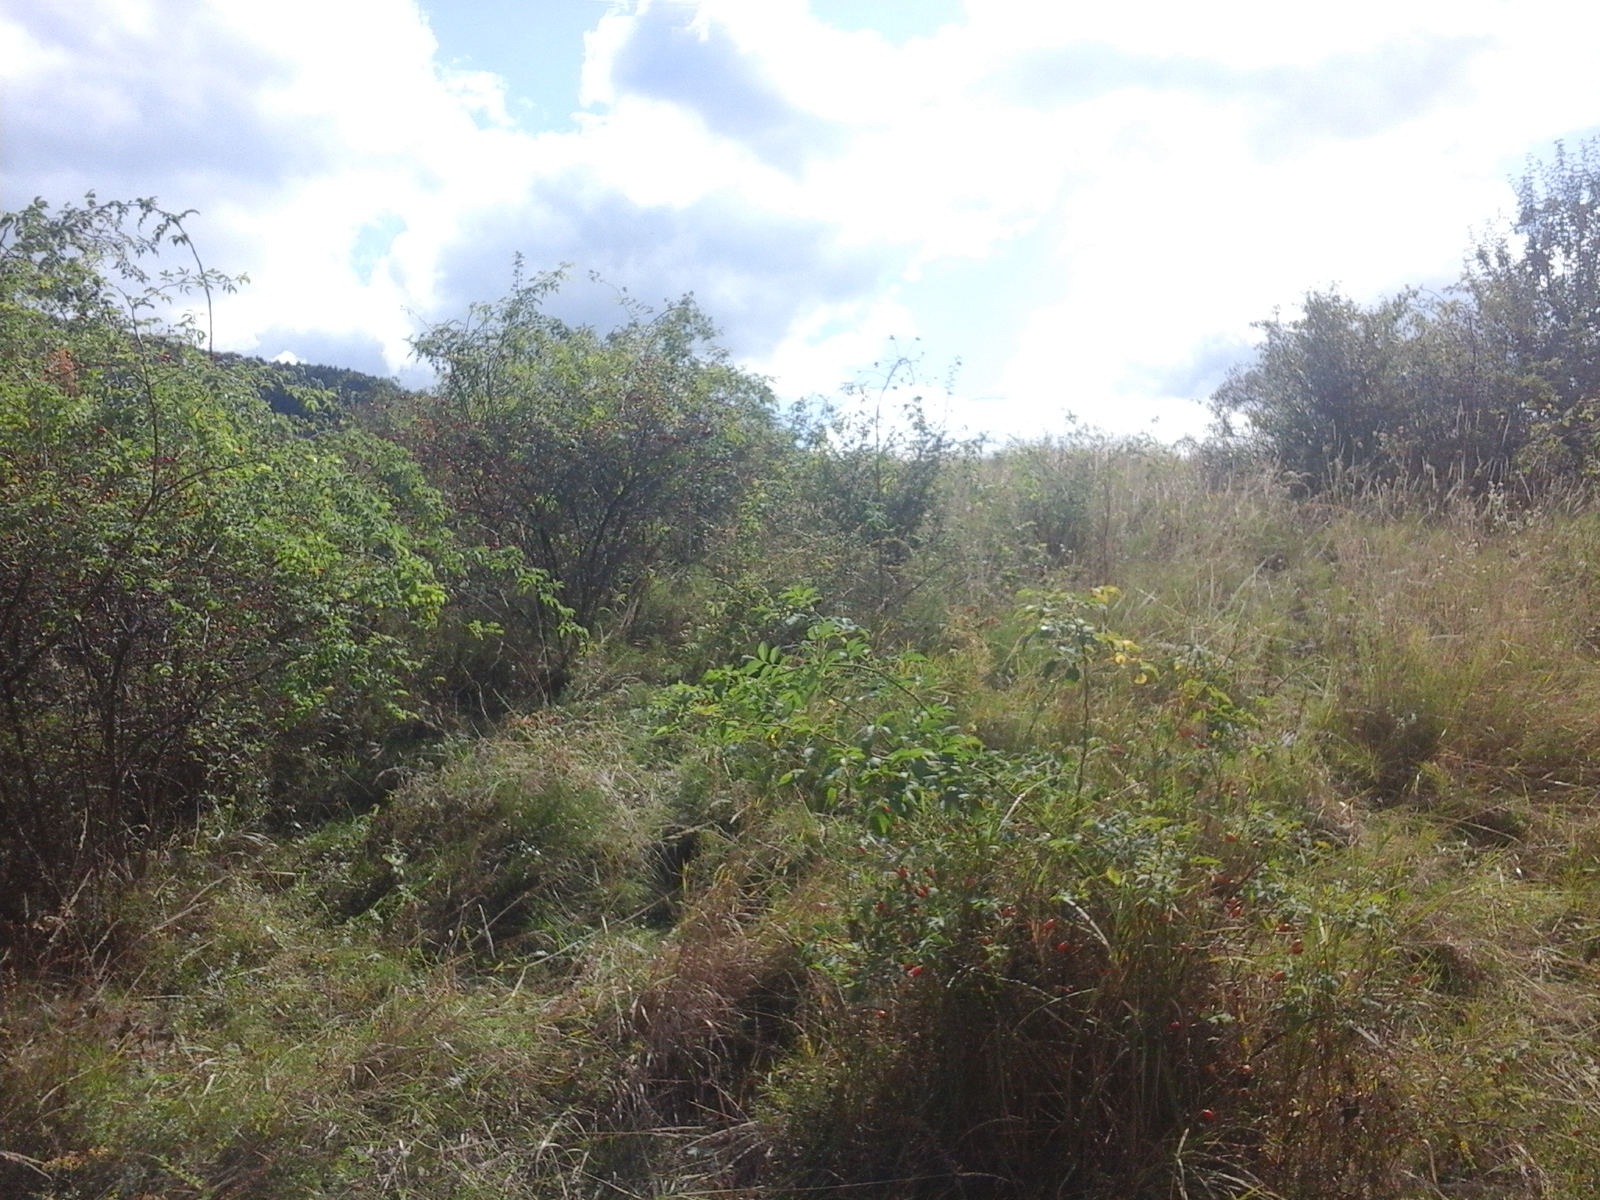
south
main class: Grassland
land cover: Grassland with sparse tree/shrub cover
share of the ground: > 75 %
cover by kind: herbaceous plants 85 %, shrubs 10 %, broadleaved forest trees 5 %
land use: Fallow land
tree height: < 5 m
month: September
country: RO
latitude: 47.3983
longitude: 23.7110
